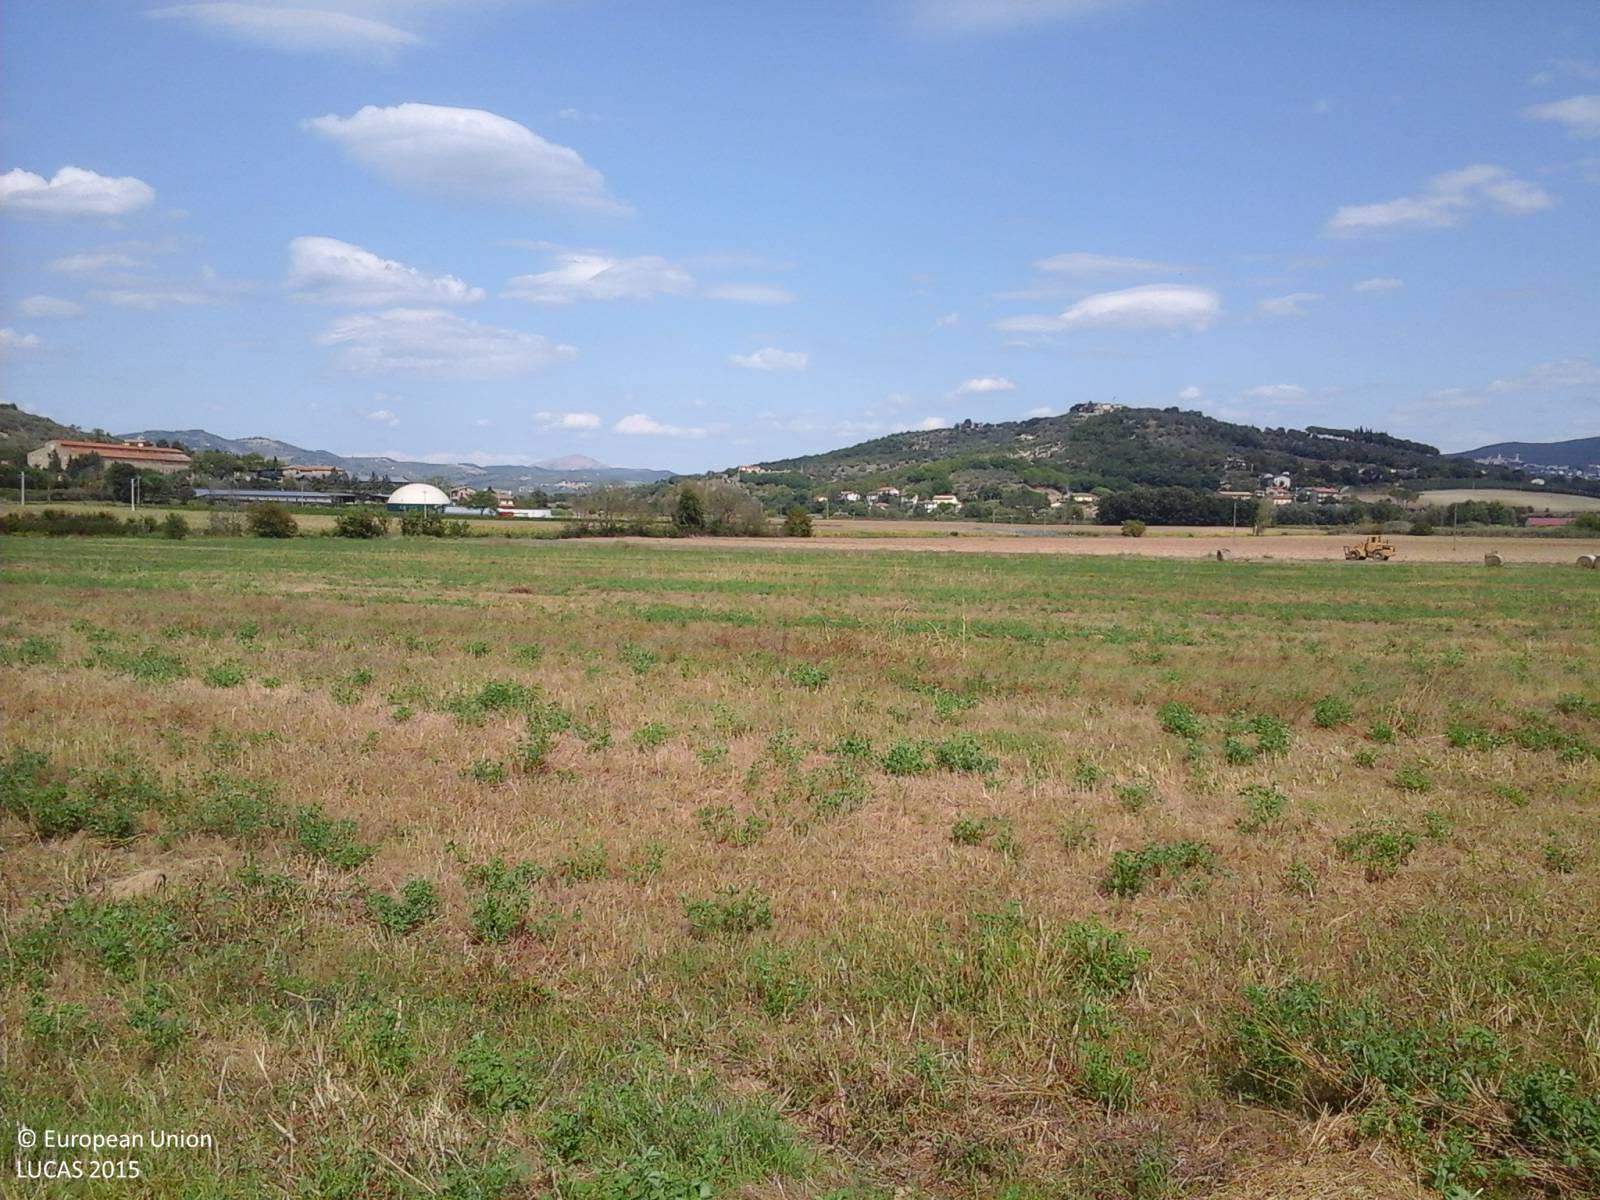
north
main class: Grassland
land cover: Grassland without tree/shrub cover
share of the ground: 50 - 75 %
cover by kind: herbaceous plants 100 %
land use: Agriculture (excluding fallow land and kitchen gardens)
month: September
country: IT
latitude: 43.0989
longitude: 12.2419
